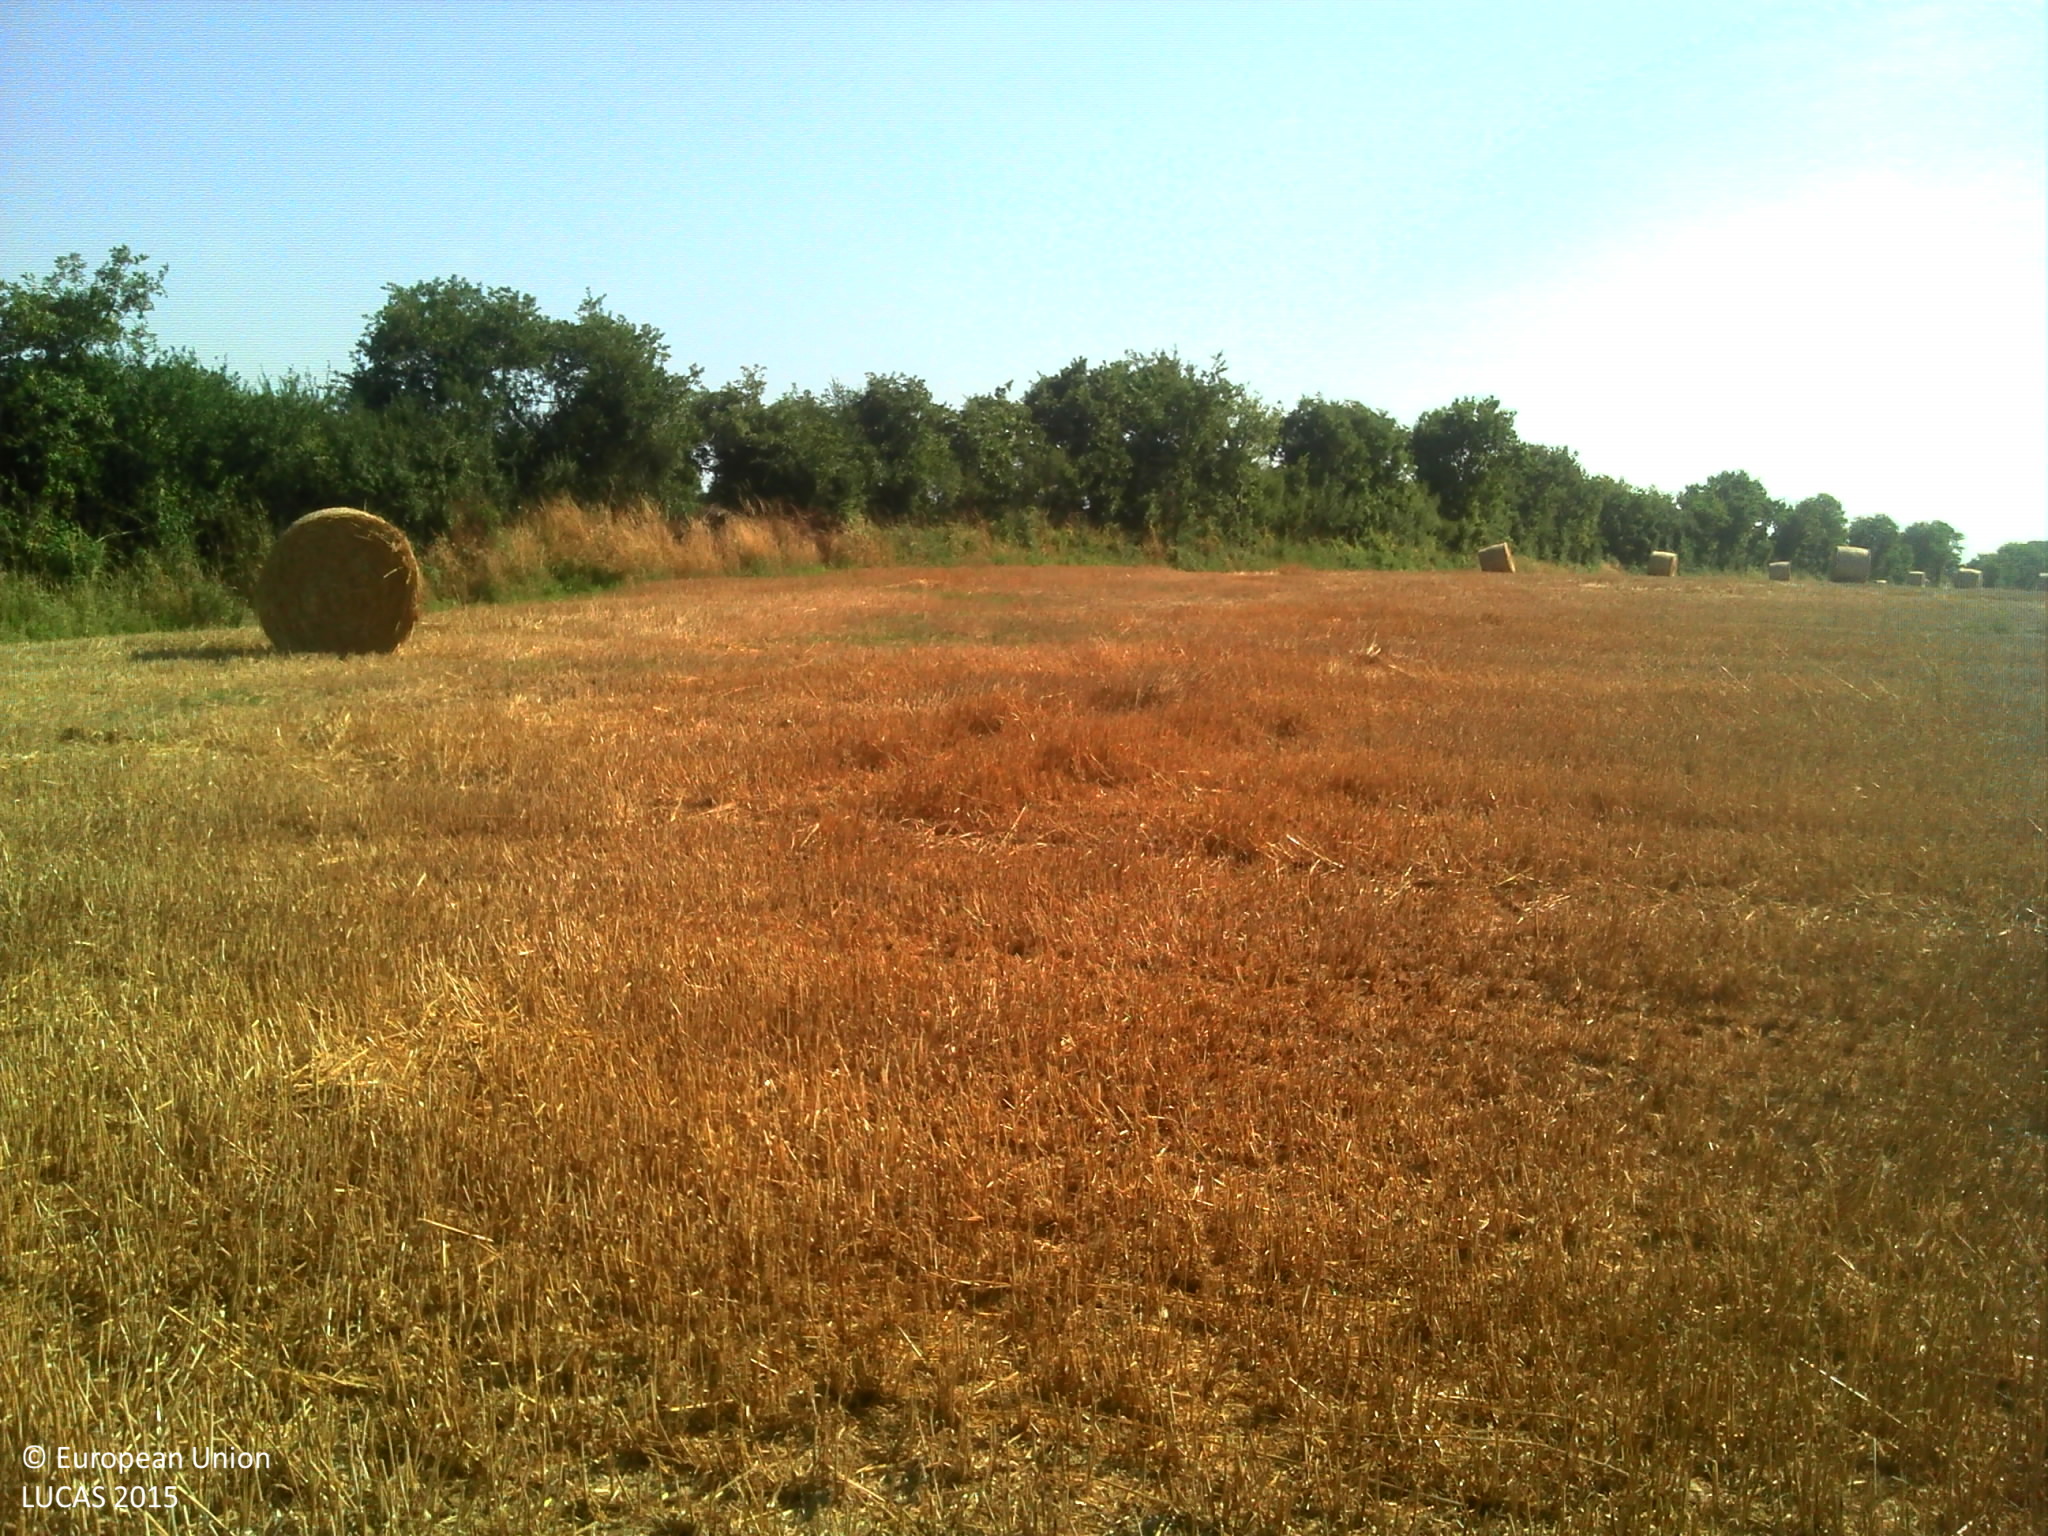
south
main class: Cropland
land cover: Common wheat
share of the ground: > 75 %
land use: Agriculture (excluding fallow land and kitchen gardens)
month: July
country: FR
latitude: 46.5506
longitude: -1.6344
